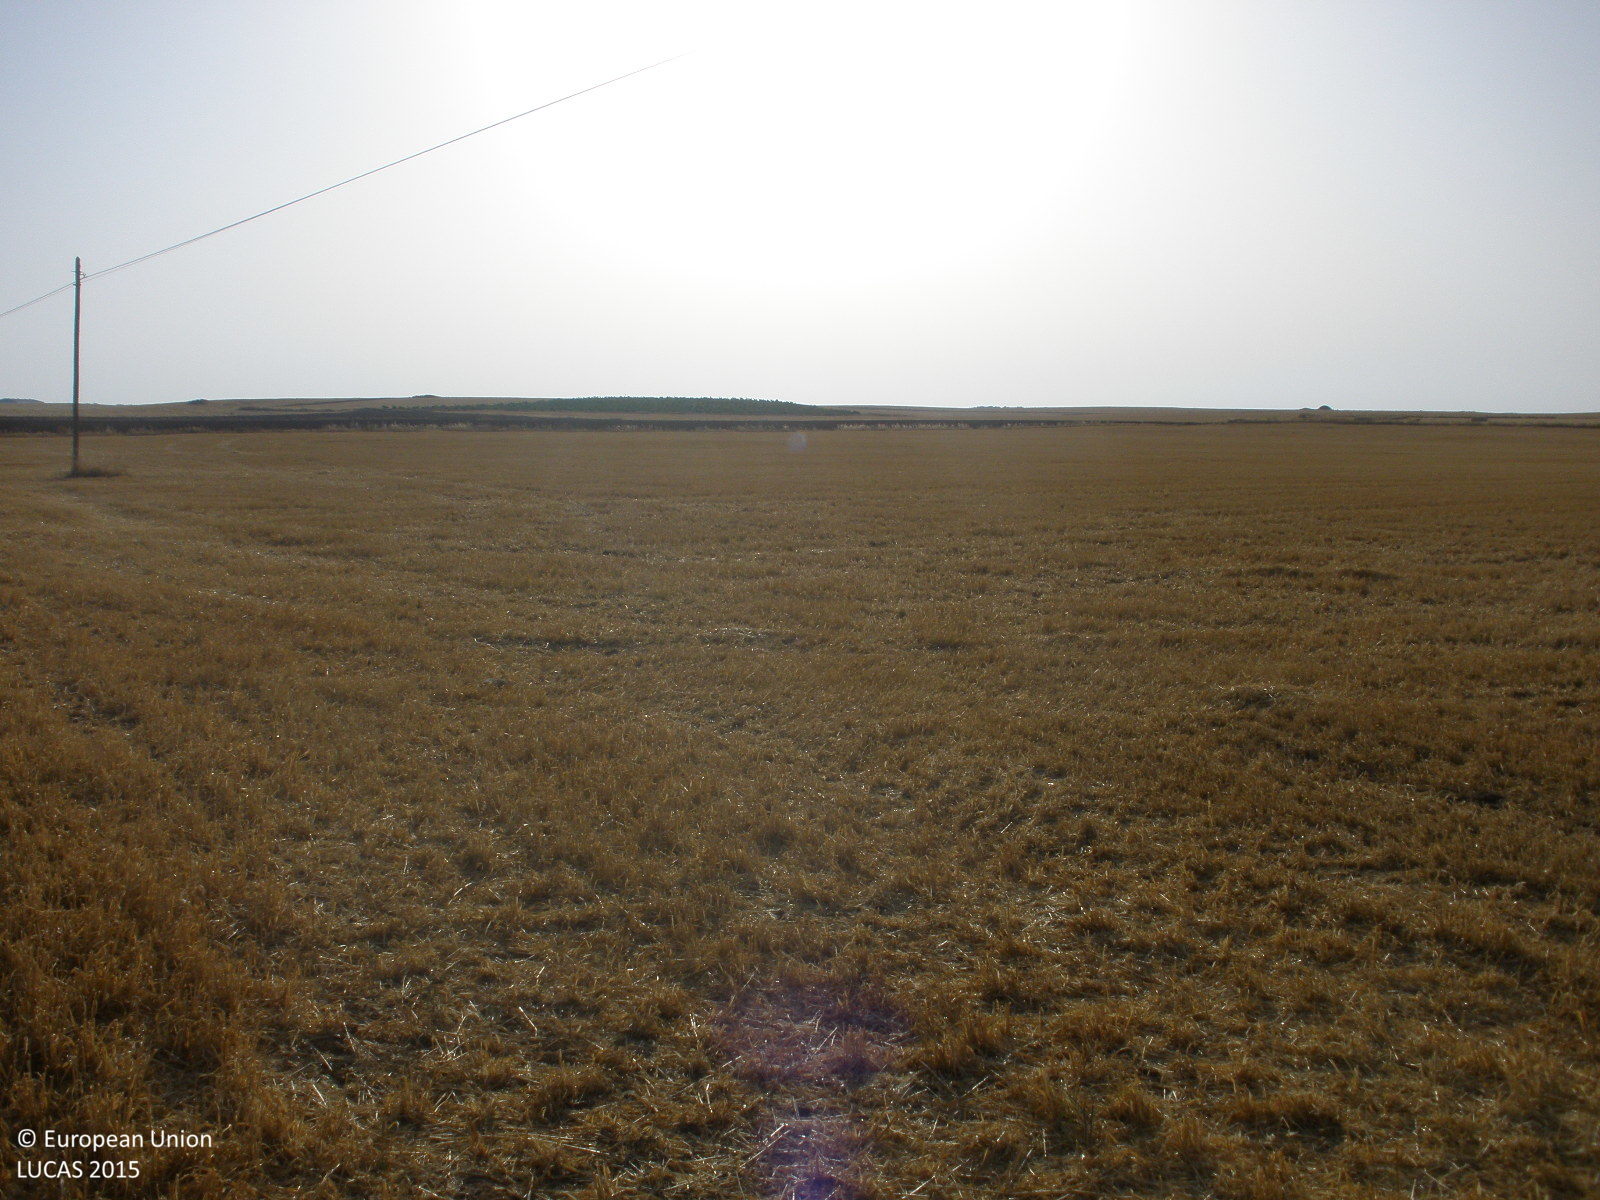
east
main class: Cropland
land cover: Oats
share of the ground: < 10 %
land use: Agriculture (excluding fallow land and kitchen gardens)
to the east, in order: Grass margins; Oats; Electric lines; Oats; Grass margins; Barley
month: July
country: ES
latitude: 39.8037
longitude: -3.1155
